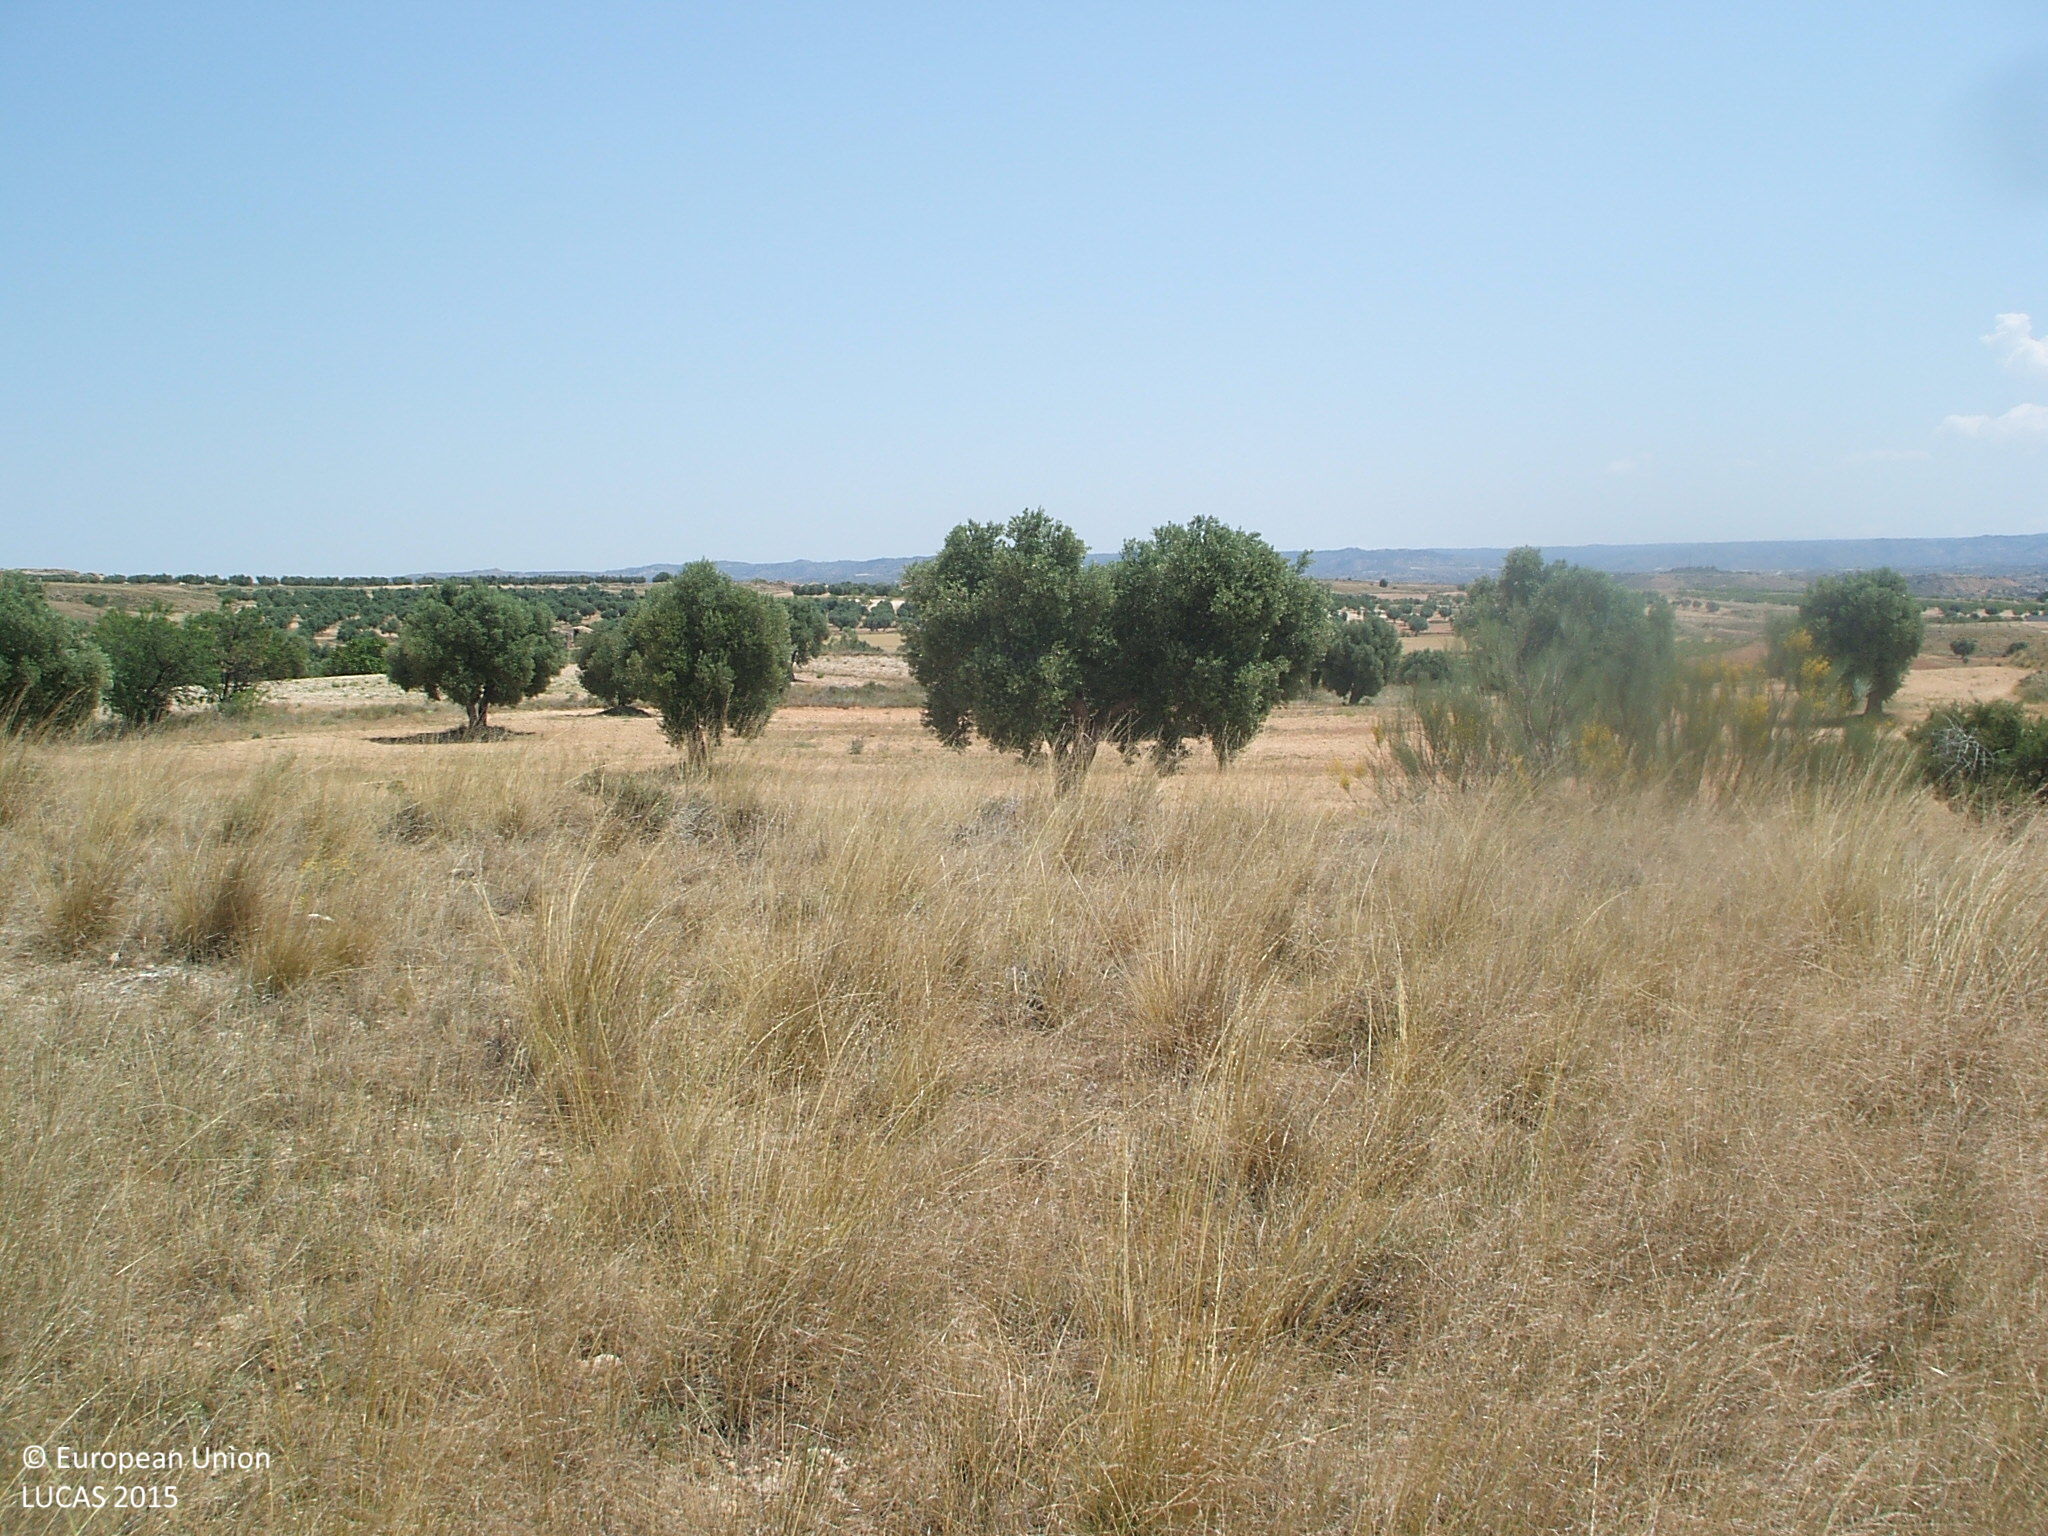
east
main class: Grassland
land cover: Grassland without tree/shrub cover
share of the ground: > 75 %
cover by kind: herbaceous plants 100 %
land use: Semi-natural and natural areas not in use
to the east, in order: Grassland without tree/shrub cover; Tracks; Grass margins; Olive groves; Grassland with sparse tree/shrub cover; Olive groves; Grass margins; Olive groves; Grass margins; Olive groves
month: June
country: ES
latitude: 40.9915
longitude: -0.1983
